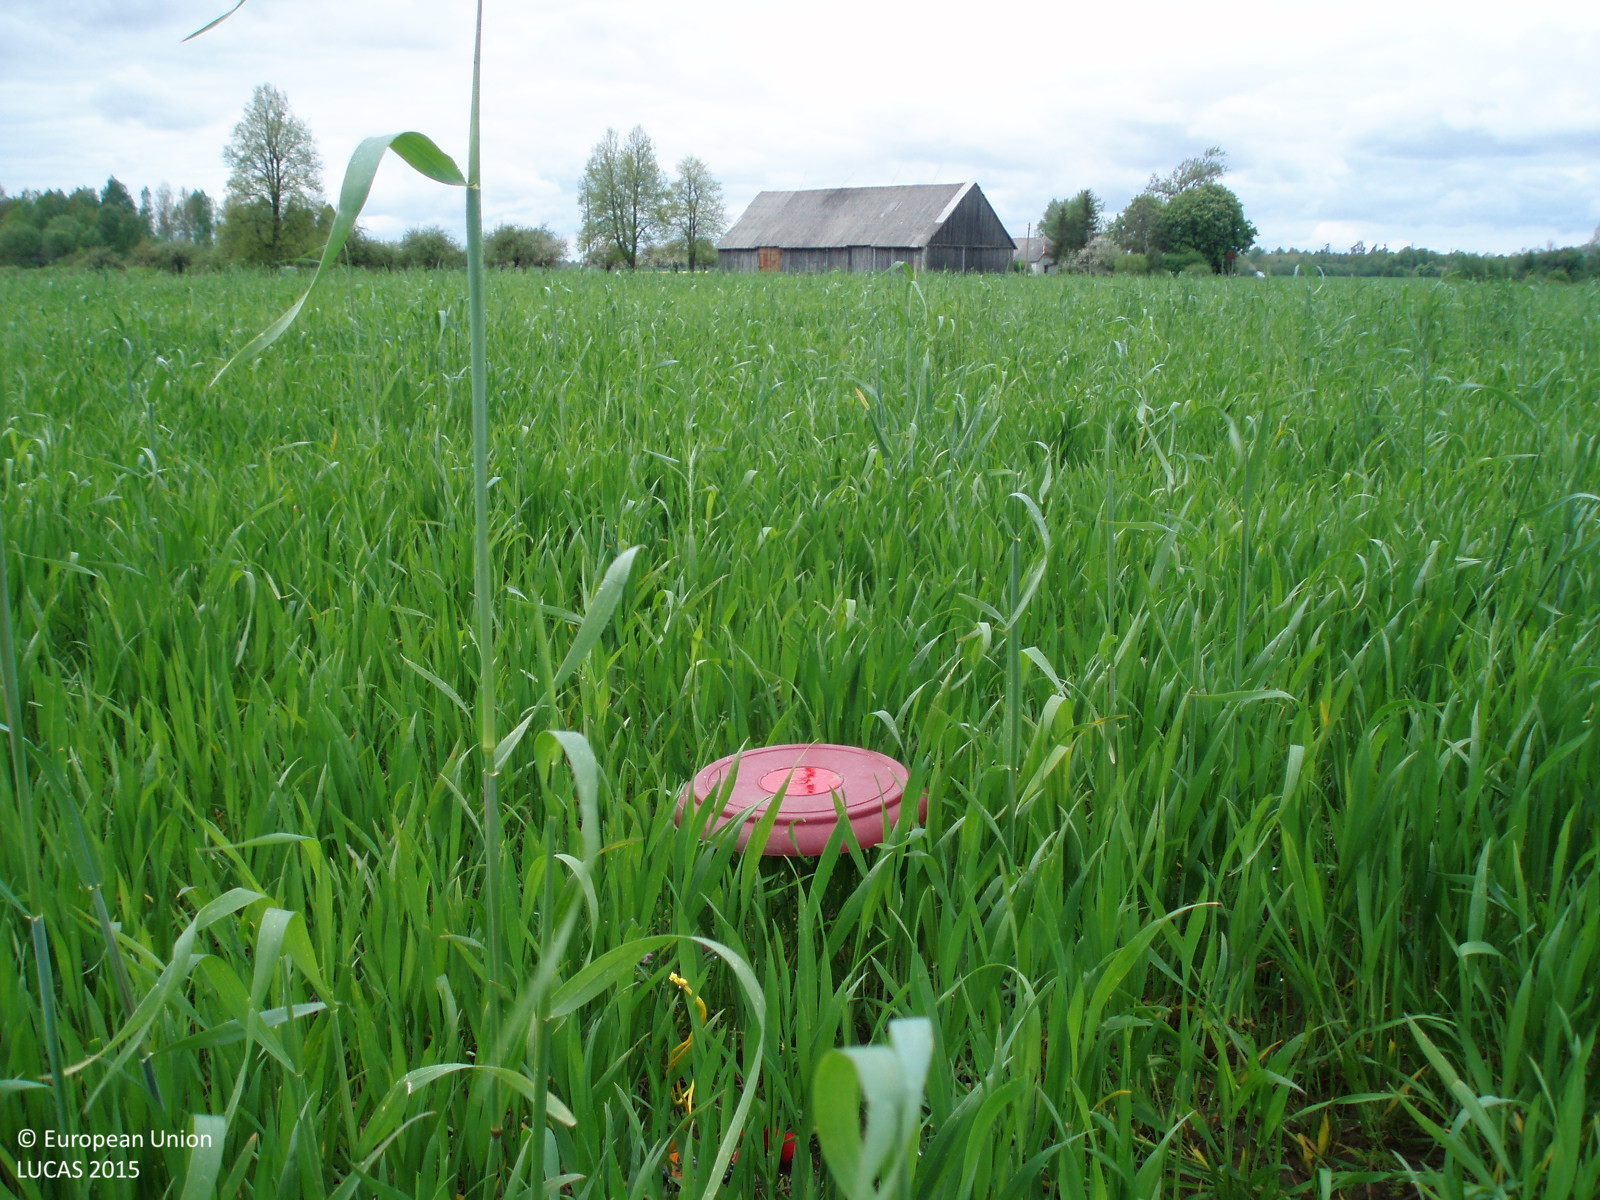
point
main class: Cropland
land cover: Rye
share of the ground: > 75 %
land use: Agriculture (excluding fallow land and kitchen gardens)
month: May
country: LT
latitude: 56.2476
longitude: 22.5008
